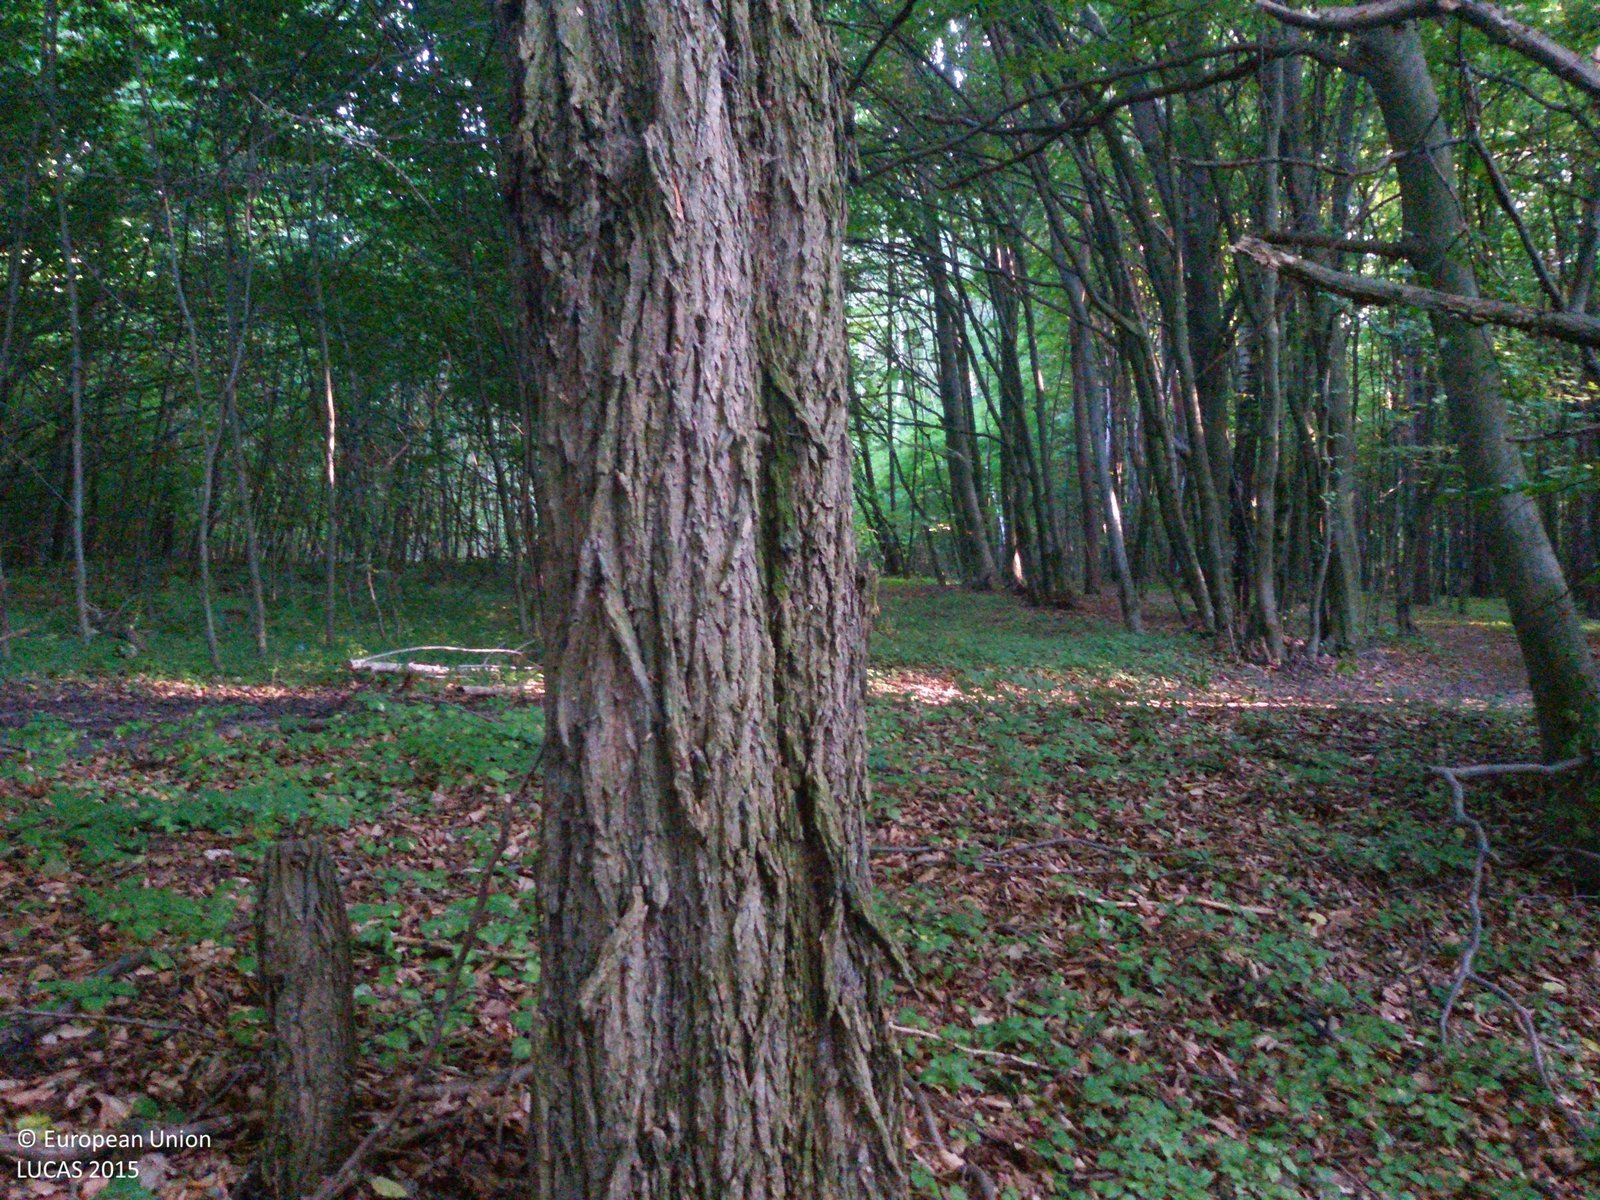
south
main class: Woodland
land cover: Broadleaved woodland
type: mesophytic deciduous forest
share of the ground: > 75 %
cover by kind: broadleaved forest trees 80 %, shrubs 10 %, herbaceous plants 10 %
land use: Forestry
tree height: > 5 m
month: July
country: PL
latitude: 50.9190
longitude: 23.4111
